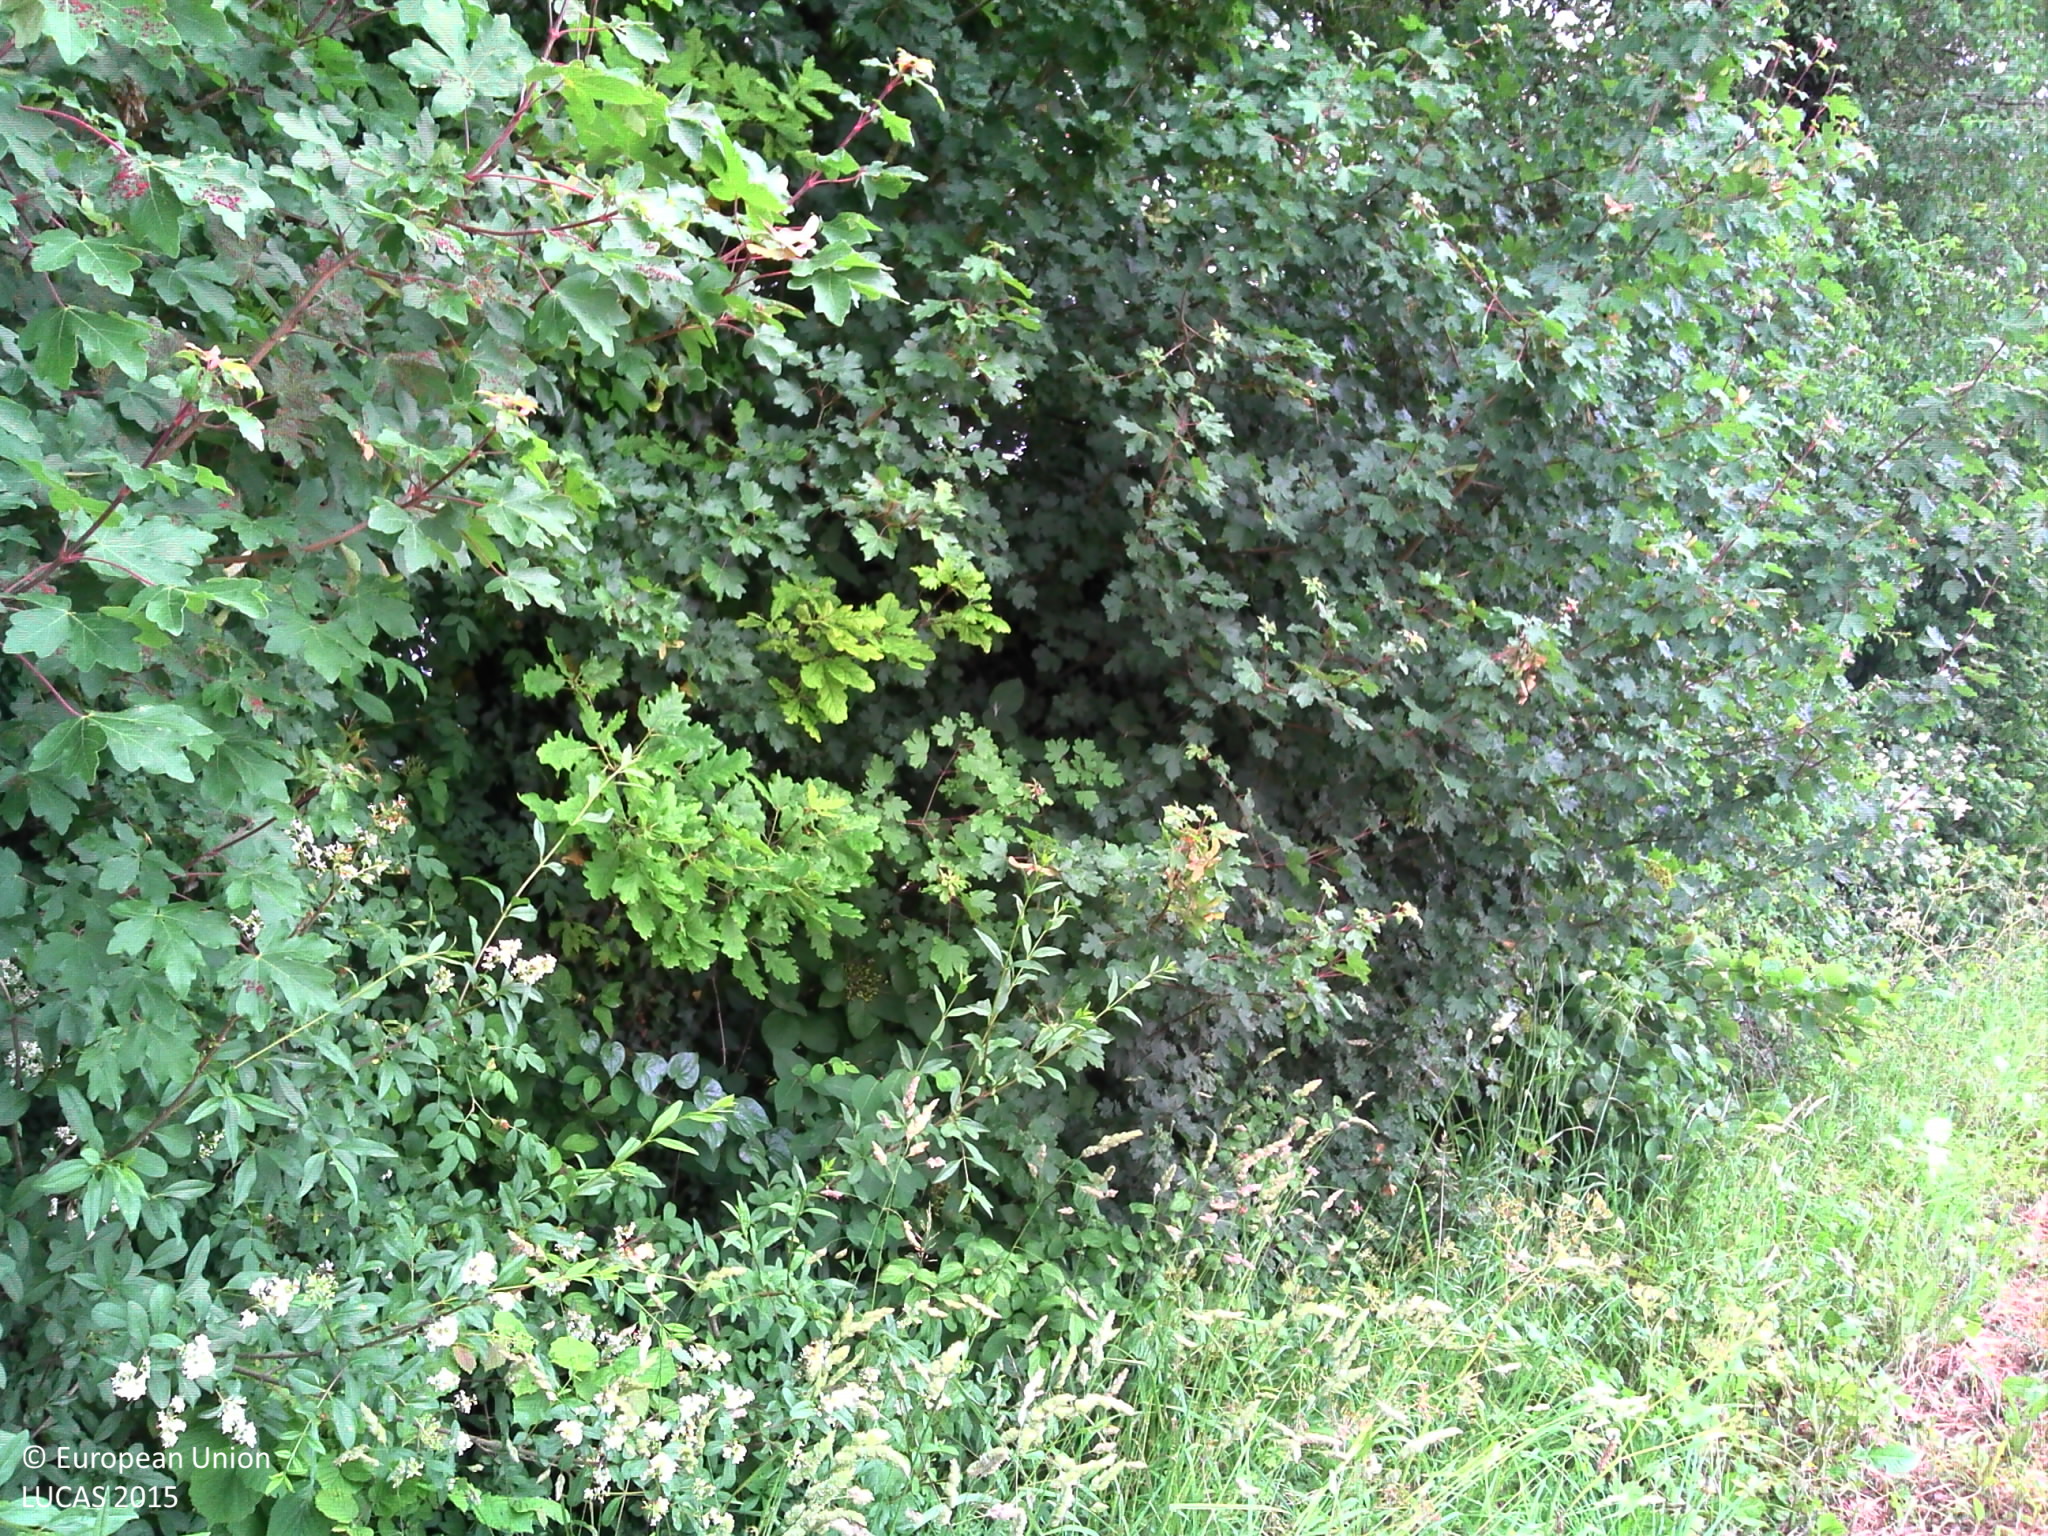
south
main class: Grassland
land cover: Grassland with sparse tree/shrub cover
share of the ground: > 75 %
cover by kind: herbaceous plants 75 %, shrubs 10 %, lichens and mosses 10 %, broadleaved forest trees 5 %
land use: Agriculture (excluding fallow land and kitchen gardens)
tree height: > 5 m
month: June
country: FR
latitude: 48.3107
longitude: 5.0503
